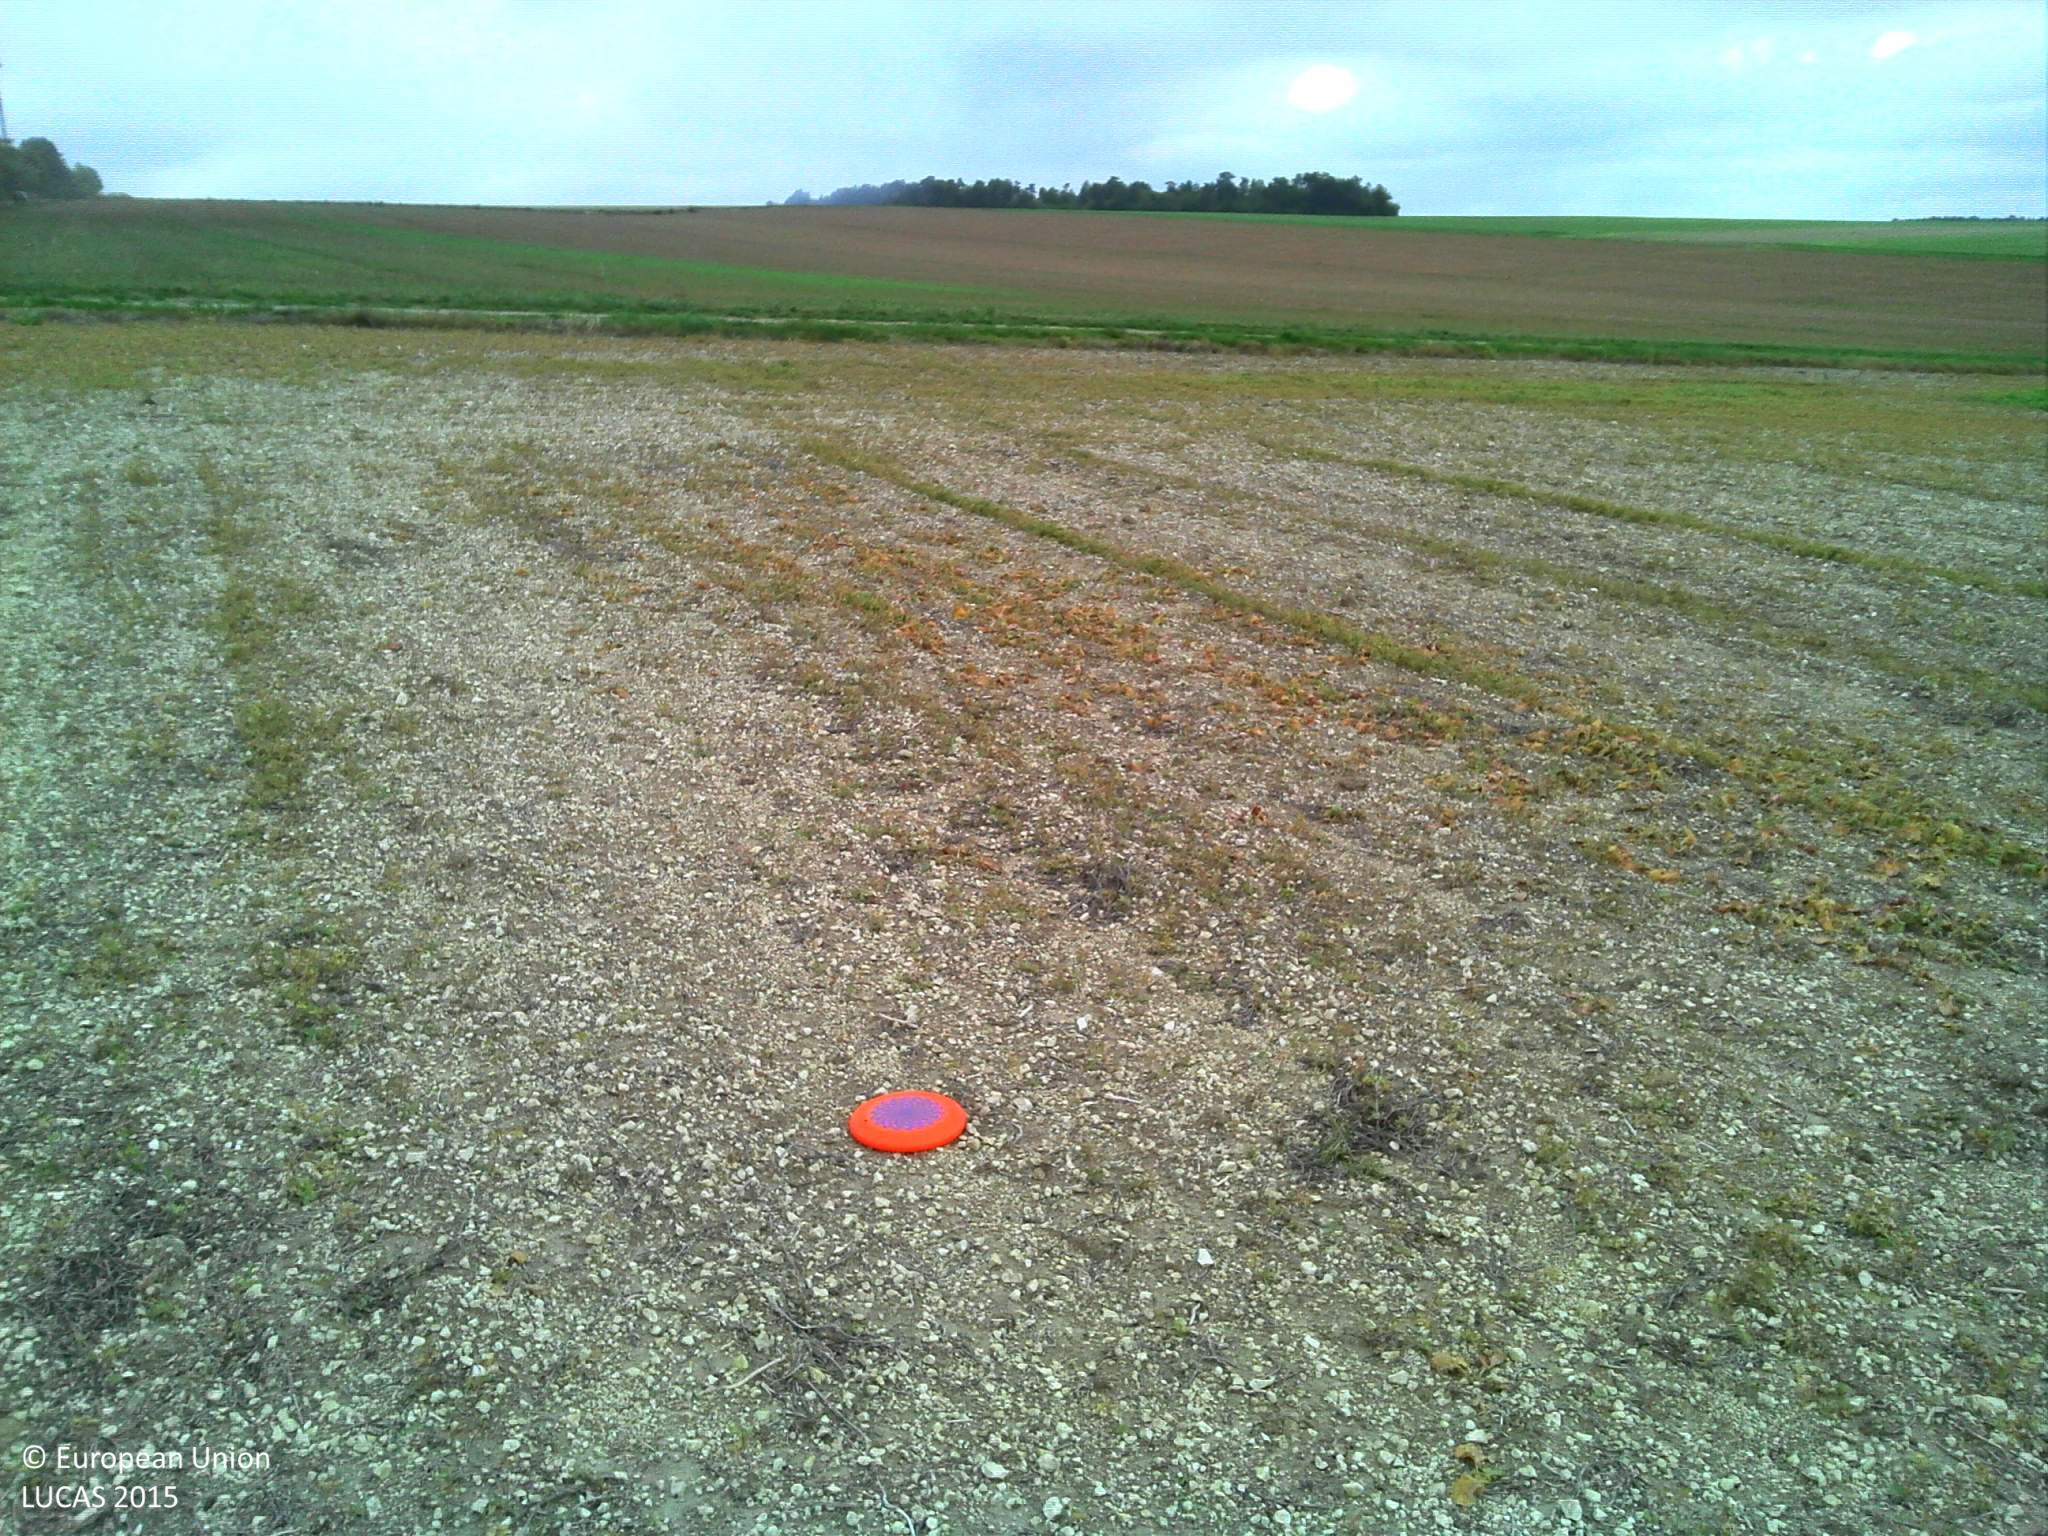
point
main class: Cropland
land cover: Soya
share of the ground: 10 - 25 %
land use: Agriculture (excluding fallow land and kitchen gardens)
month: September
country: FR
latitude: 48.3599
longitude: 4.2066
